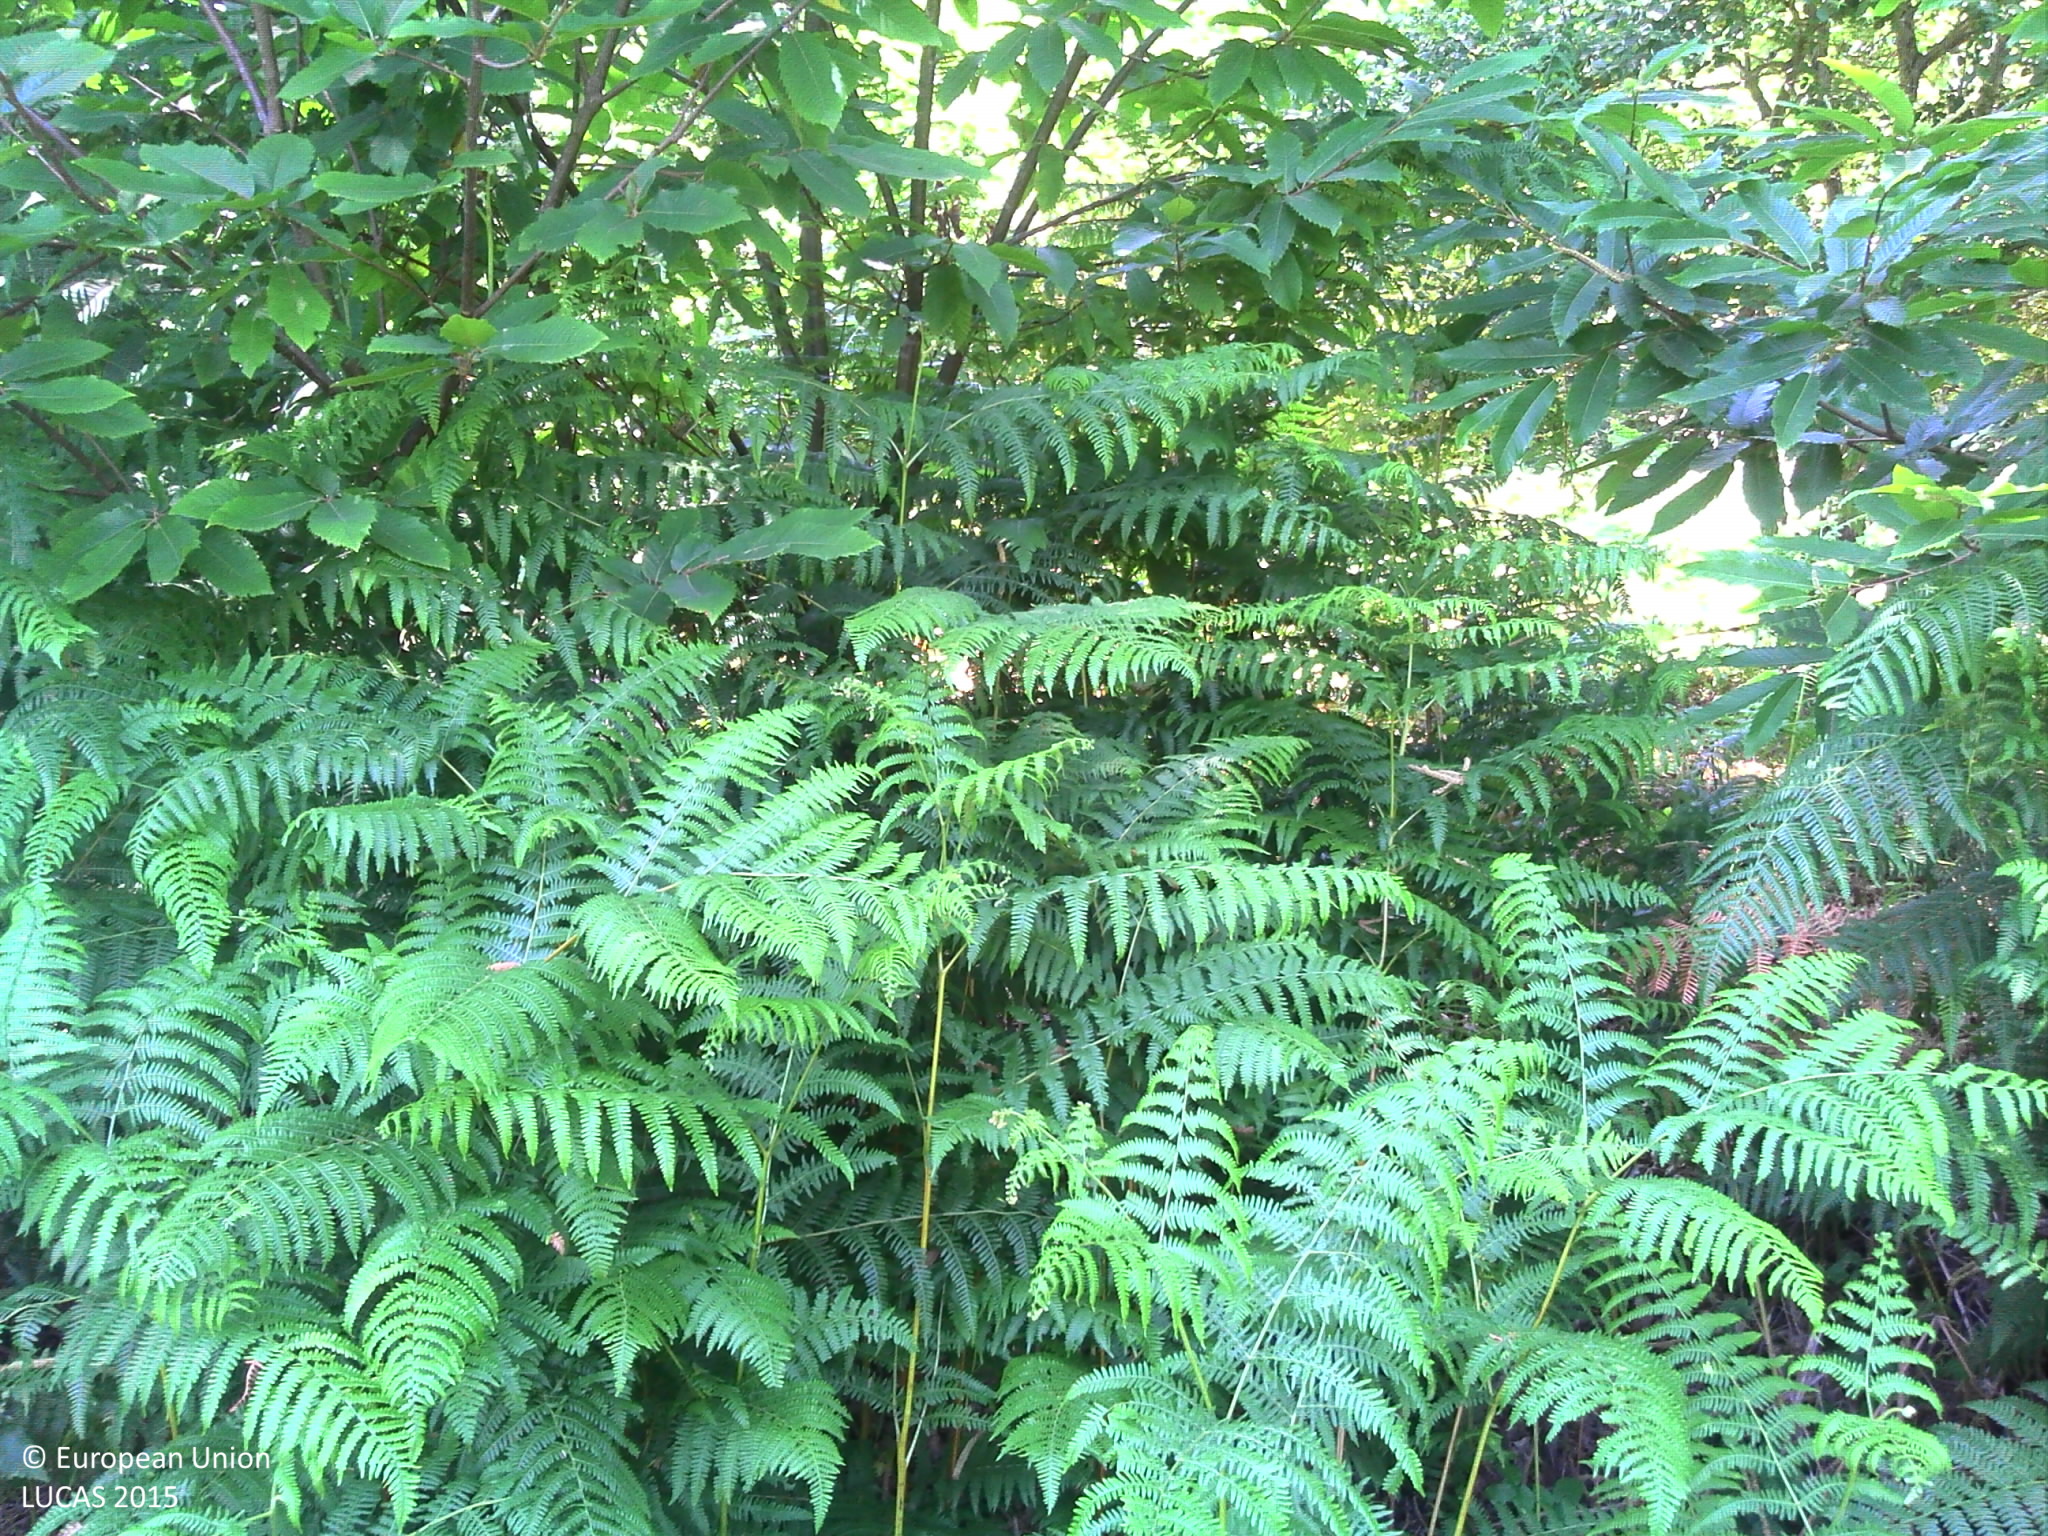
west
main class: Grassland
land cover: Grassland without tree/shrub cover
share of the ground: > 75 %
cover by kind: herbaceous plants 95 %, shrubs 5 %
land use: Community services
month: July
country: FR
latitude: 46.1344
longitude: 1.6692
